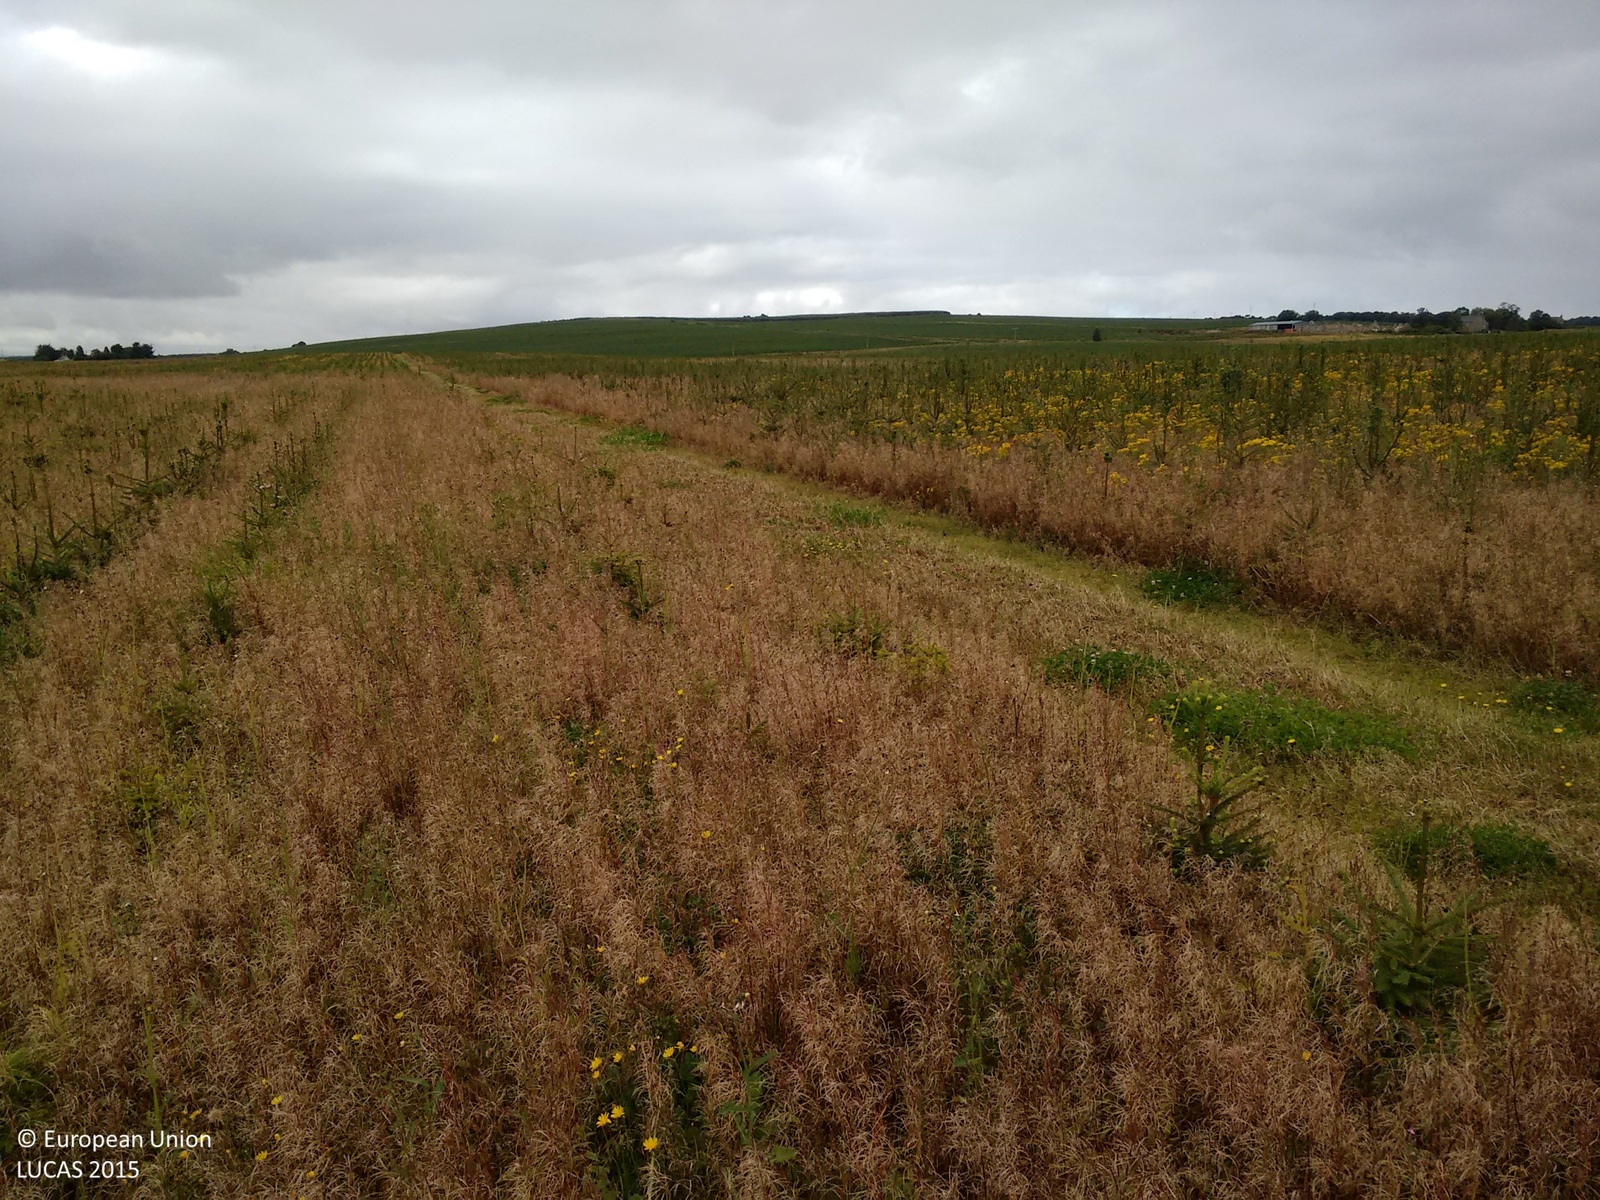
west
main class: Woodland
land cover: Spruce dominated coniferous woodland
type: exotic forest
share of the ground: < 10 %
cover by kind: herbaceous plants 90 %, coniferous forest trees 10 %
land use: Forestry
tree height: < 5 m
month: September
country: GB
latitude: 57.6902
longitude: -3.4033
